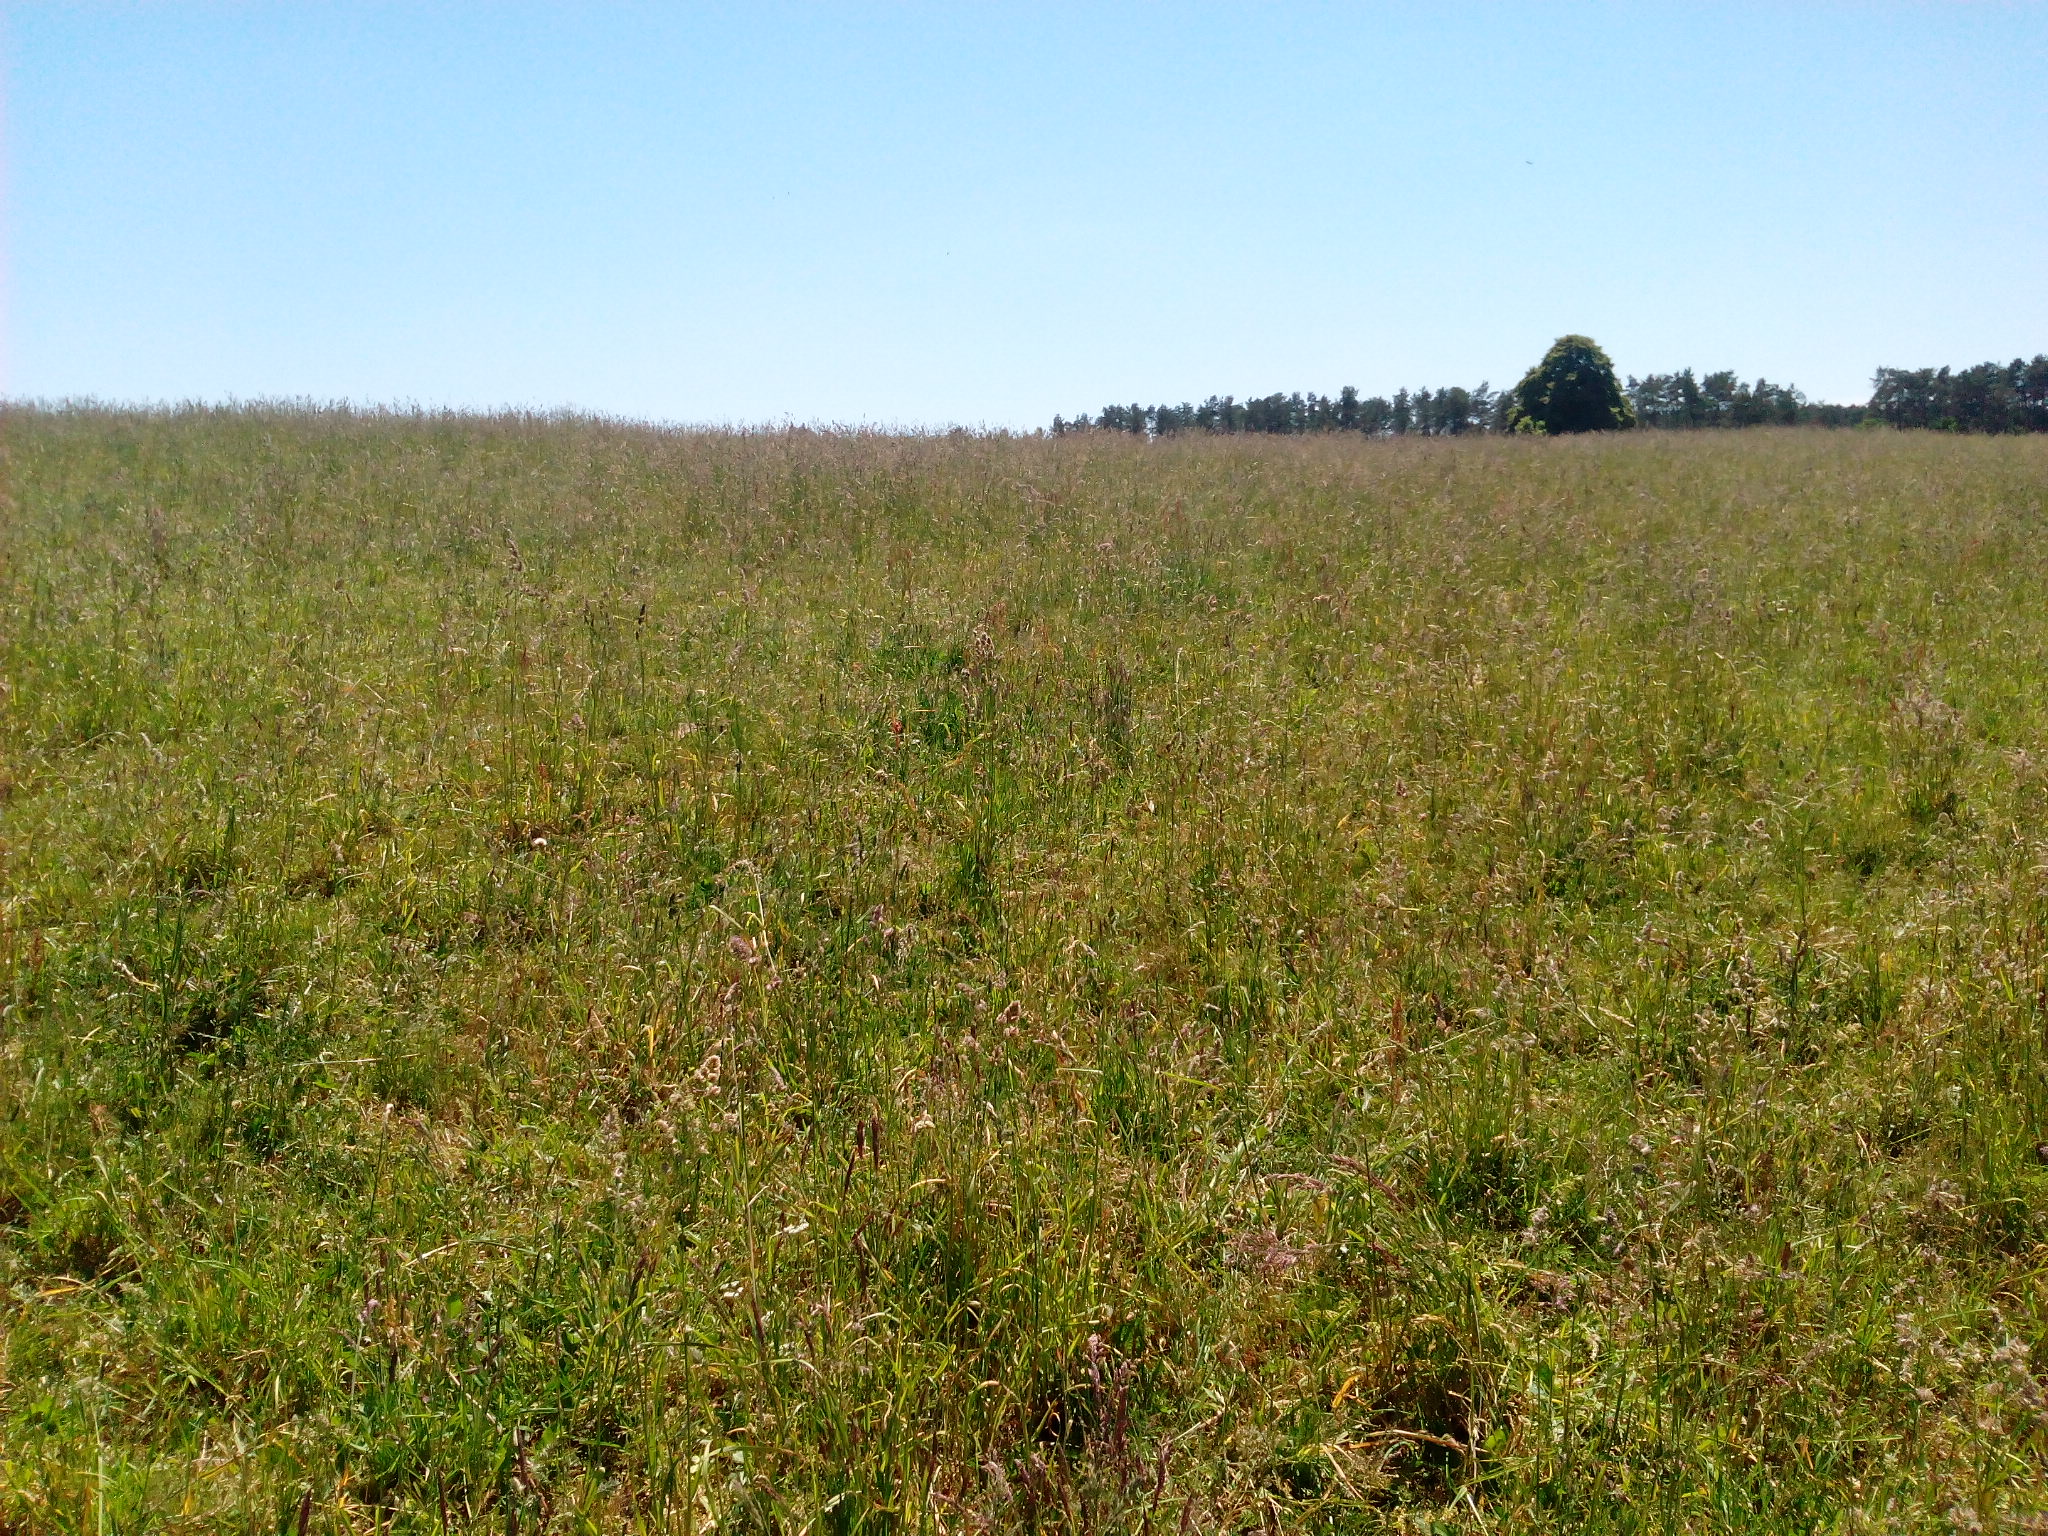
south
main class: Grassland
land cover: Grassland without tree/shrub cover
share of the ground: > 75 %
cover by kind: herbaceous plants 95 %, shrubs 5 %
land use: Agriculture (excluding fallow land and kitchen gardens)
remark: Harvested field
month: June
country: DE
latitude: 53.1693
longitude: 13.5753
